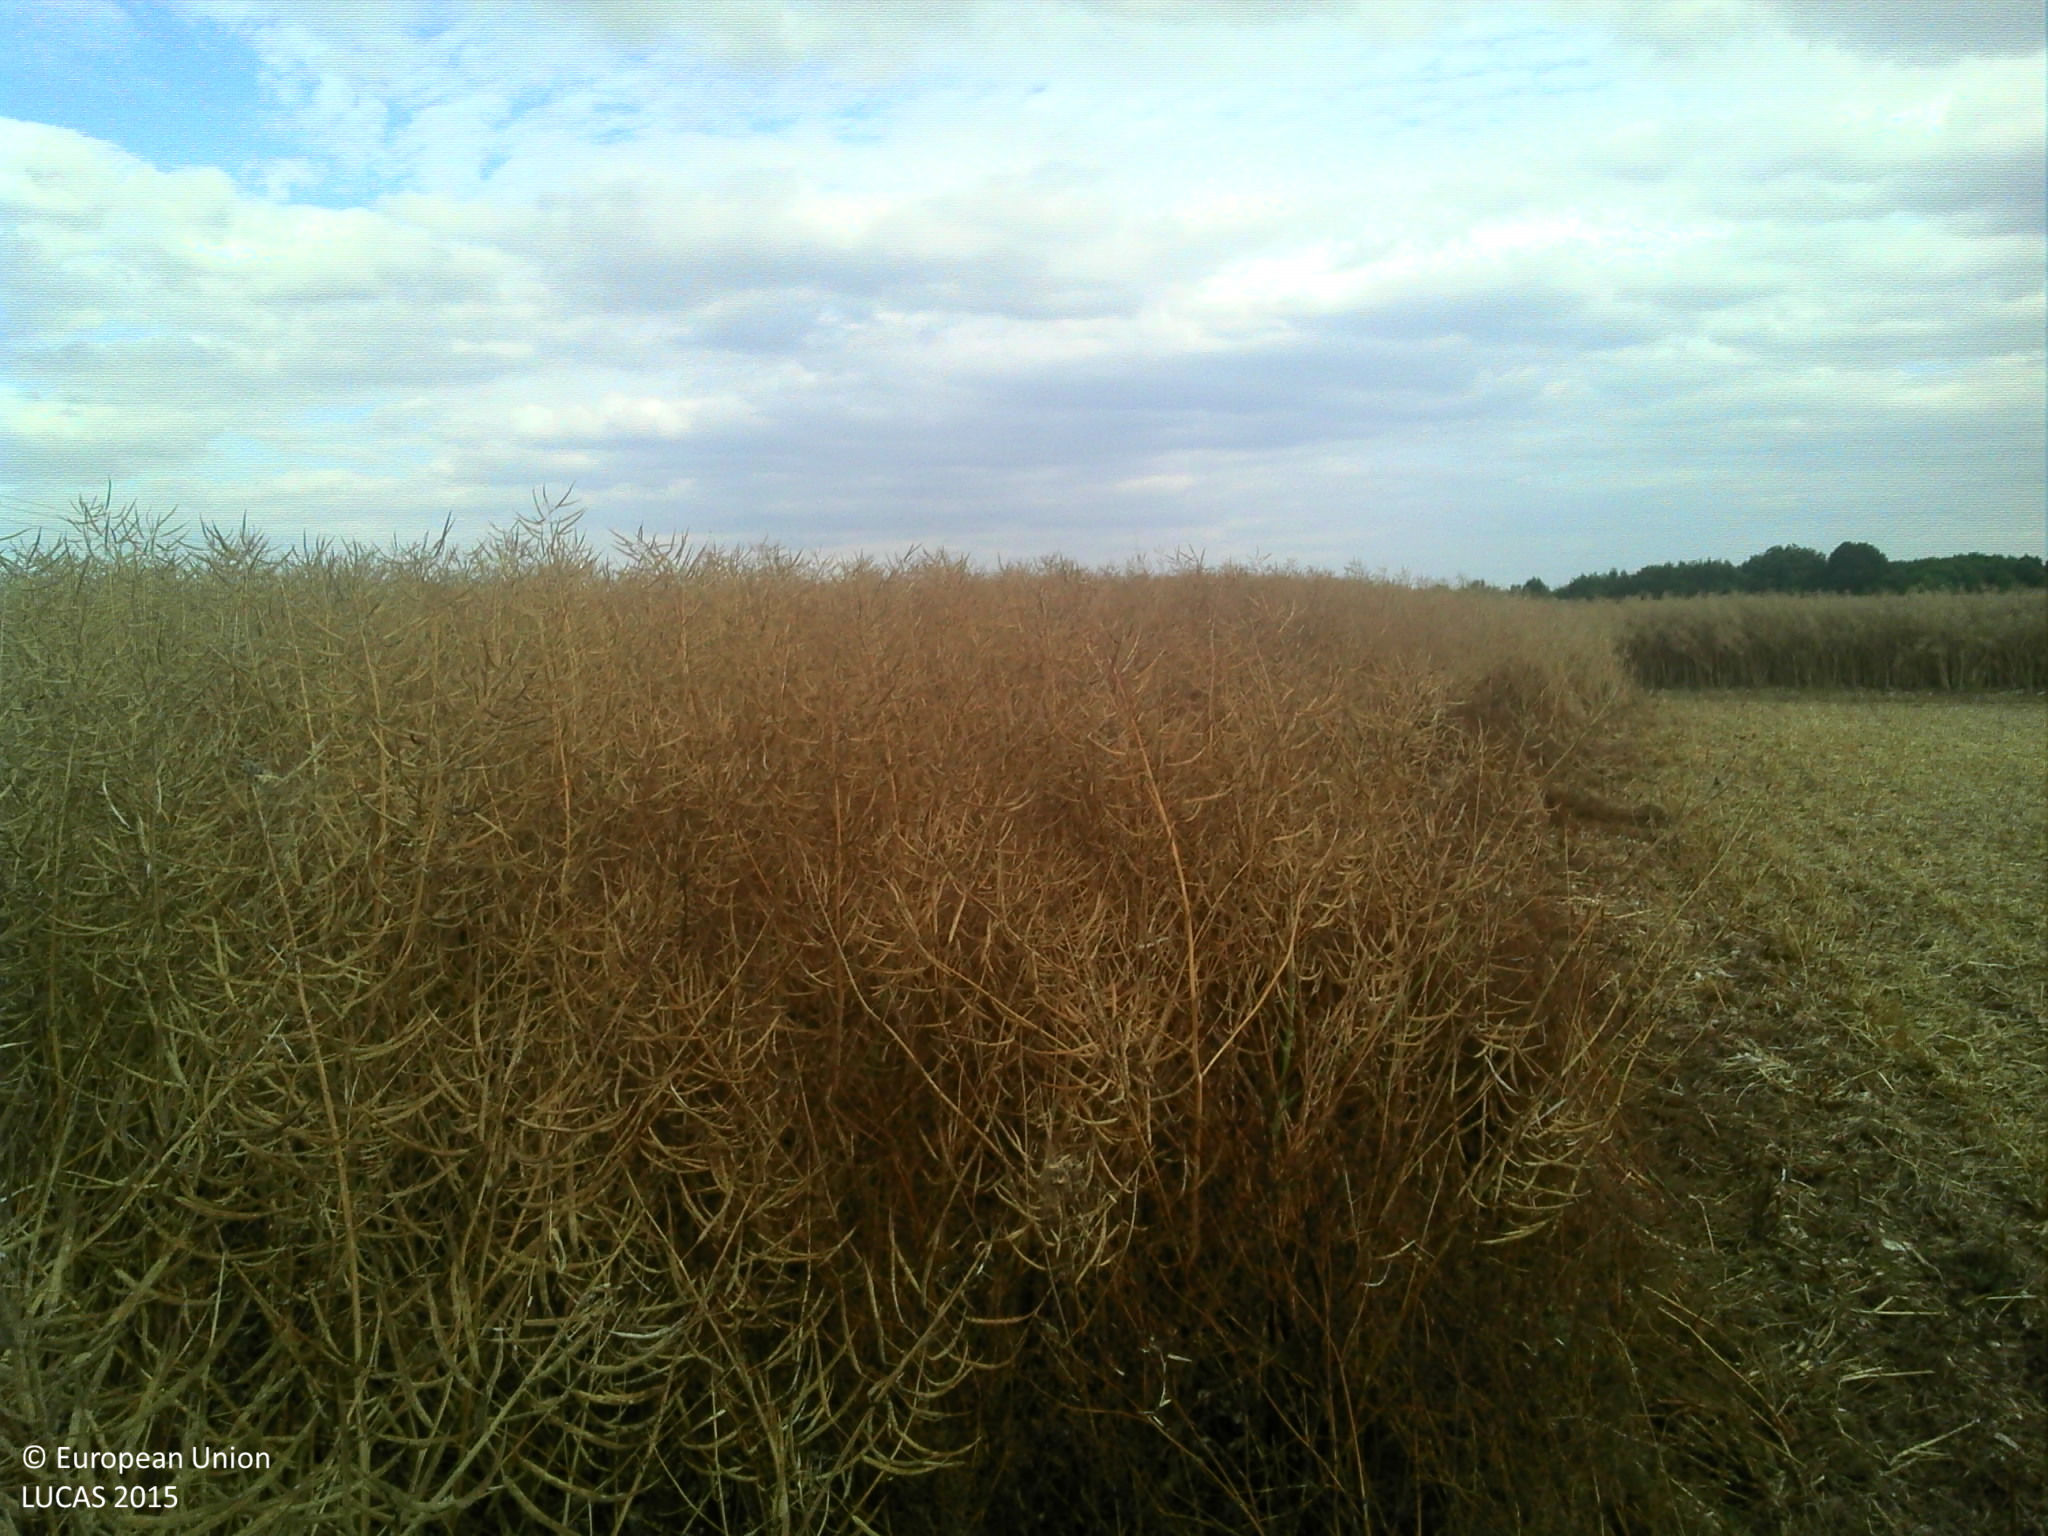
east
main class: Cropland
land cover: Rape and turnip rape
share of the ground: > 75 %
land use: Agriculture (excluding fallow land and kitchen gardens)
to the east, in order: Rape and turnip rape; Grass margins; Tracks; Grass margins; Rape and turnip rape; Electric lines; Rape and turnip rape
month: July
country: FR
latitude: 48.1024
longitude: 5.2321
